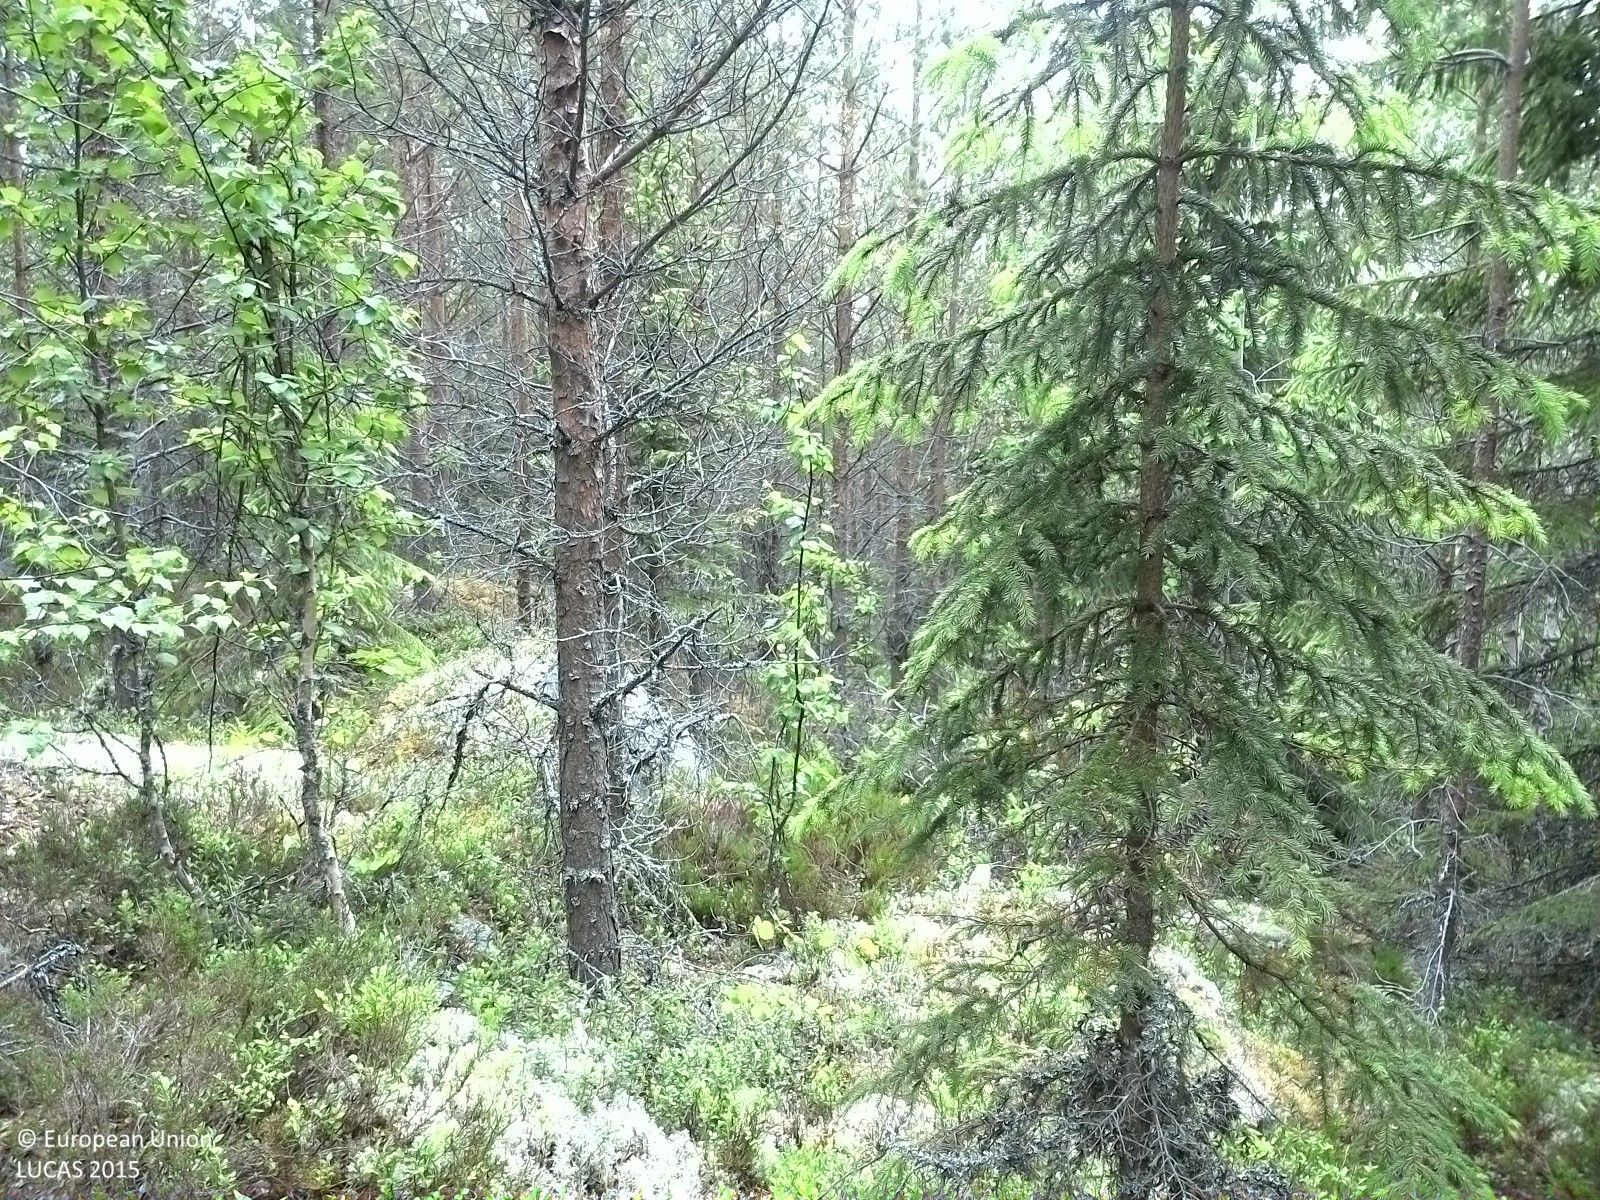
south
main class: Woodland
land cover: Pine dominated coniferous woodland
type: boreal forest
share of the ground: 50 - 75 %
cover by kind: coniferous forest trees 50 %, shrubs 30 %, broadleaved forest trees 10 %, lichens and mosses 10 %
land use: Forestry
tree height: > 5 m
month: June
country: SE
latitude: 62.1420
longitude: 16.1771
